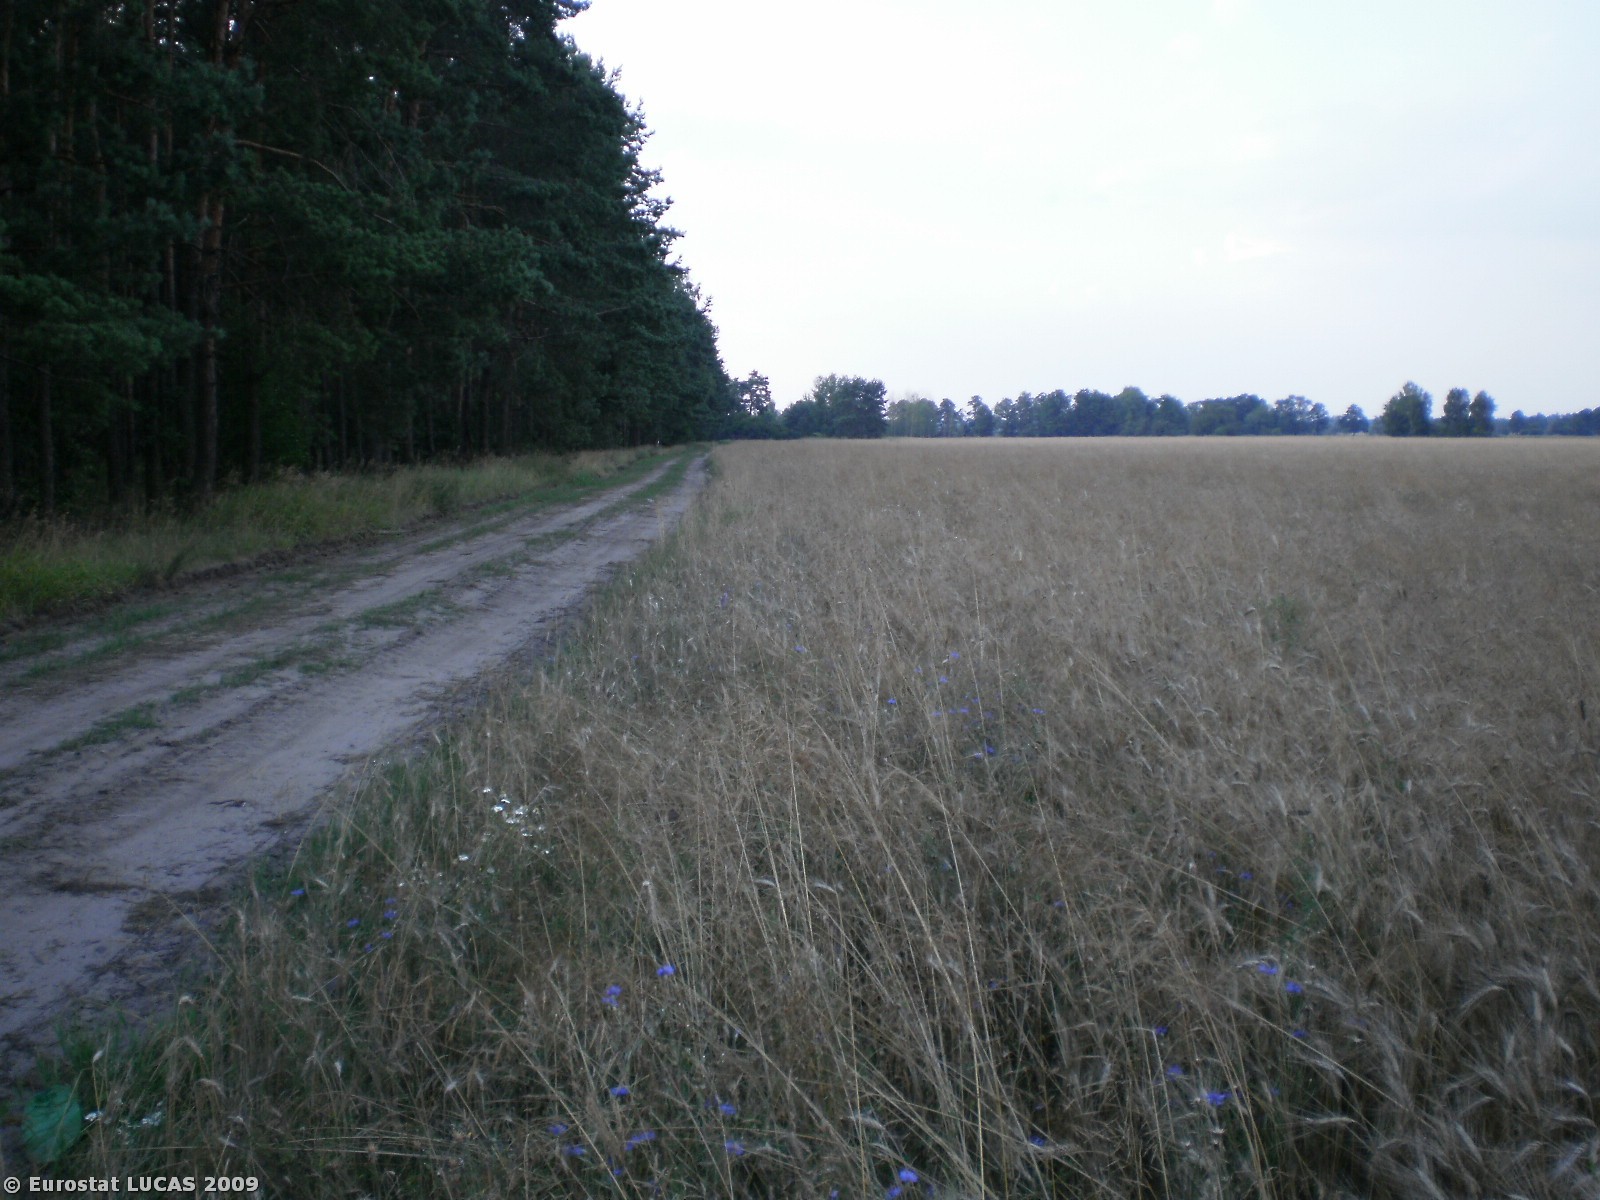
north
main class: Cropland
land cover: Triticale
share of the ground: > 75 %
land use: Agriculture (excluding fallow land and kitchen gardens)
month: July
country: PL
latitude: 53.4065
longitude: 21.0095
